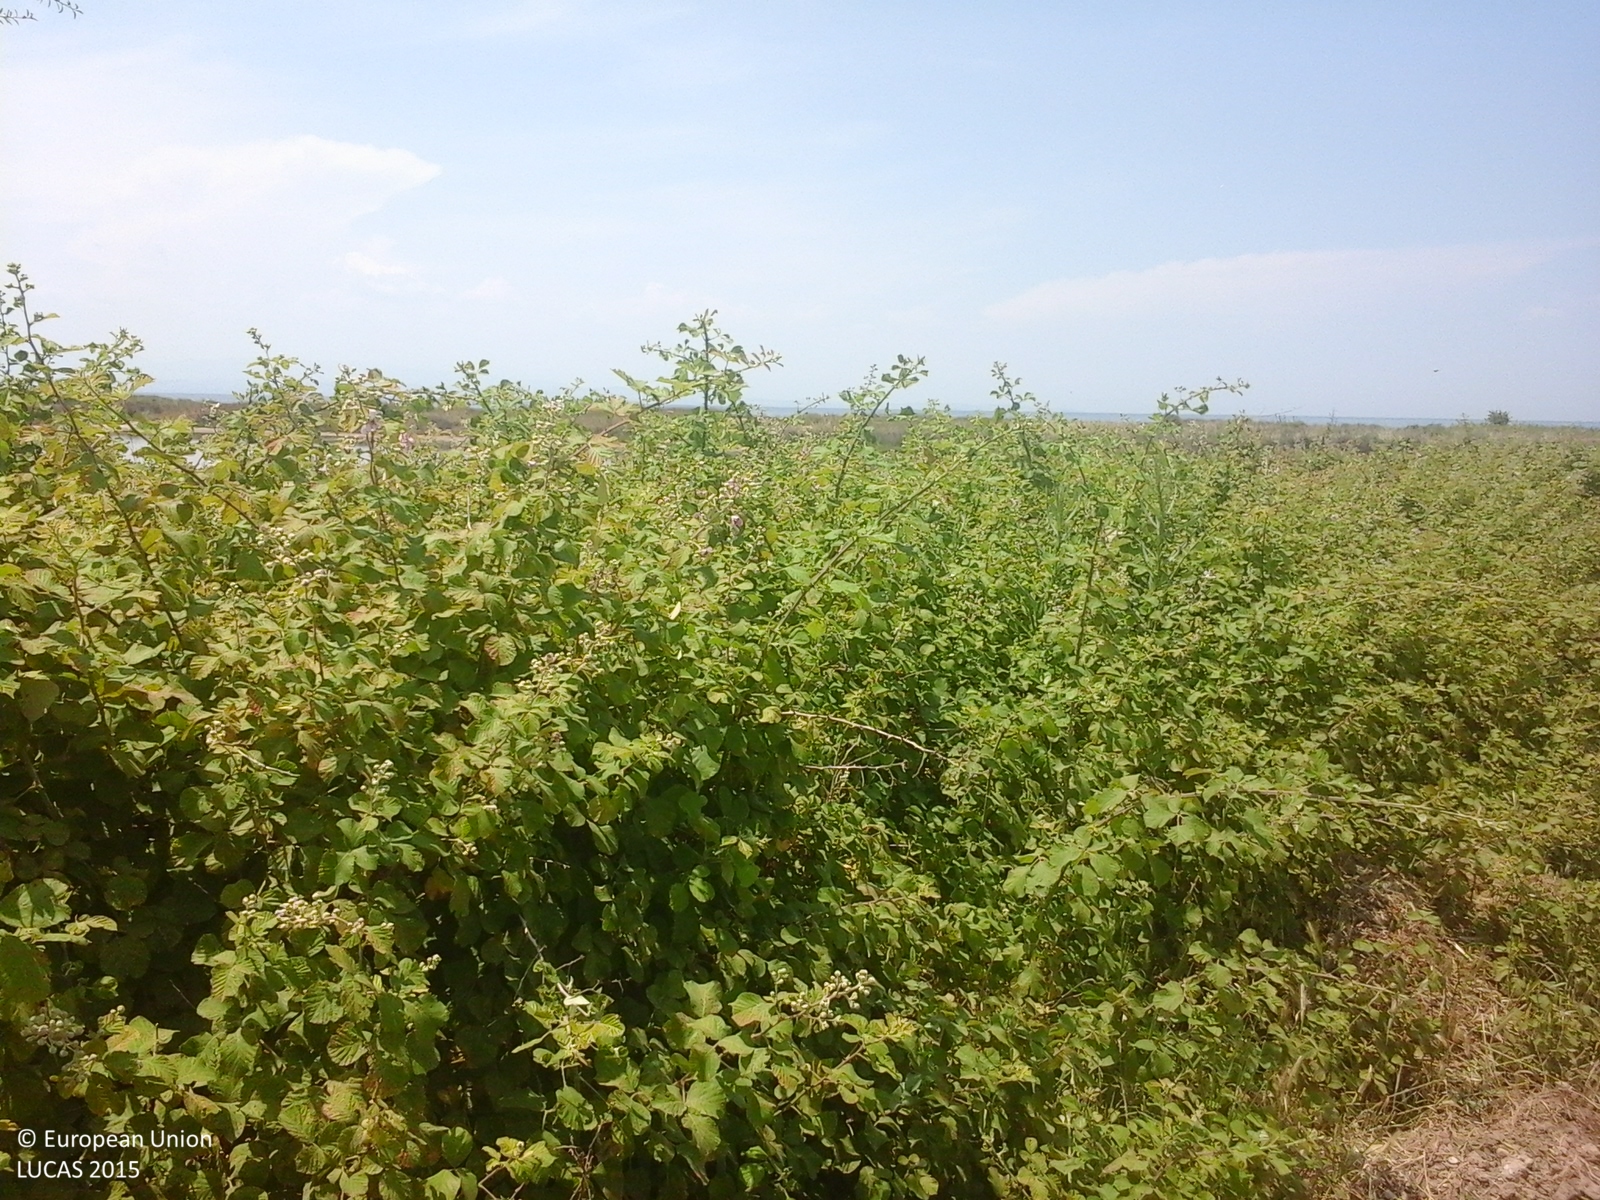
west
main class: Shrubland
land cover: Shrubland with sparse tree cover
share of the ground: > 75 %
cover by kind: shrubs 95 %, broadleaved forest trees 5 %
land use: Semi-natural and natural areas not in use
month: June
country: GR
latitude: 40.4407
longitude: 22.8662
